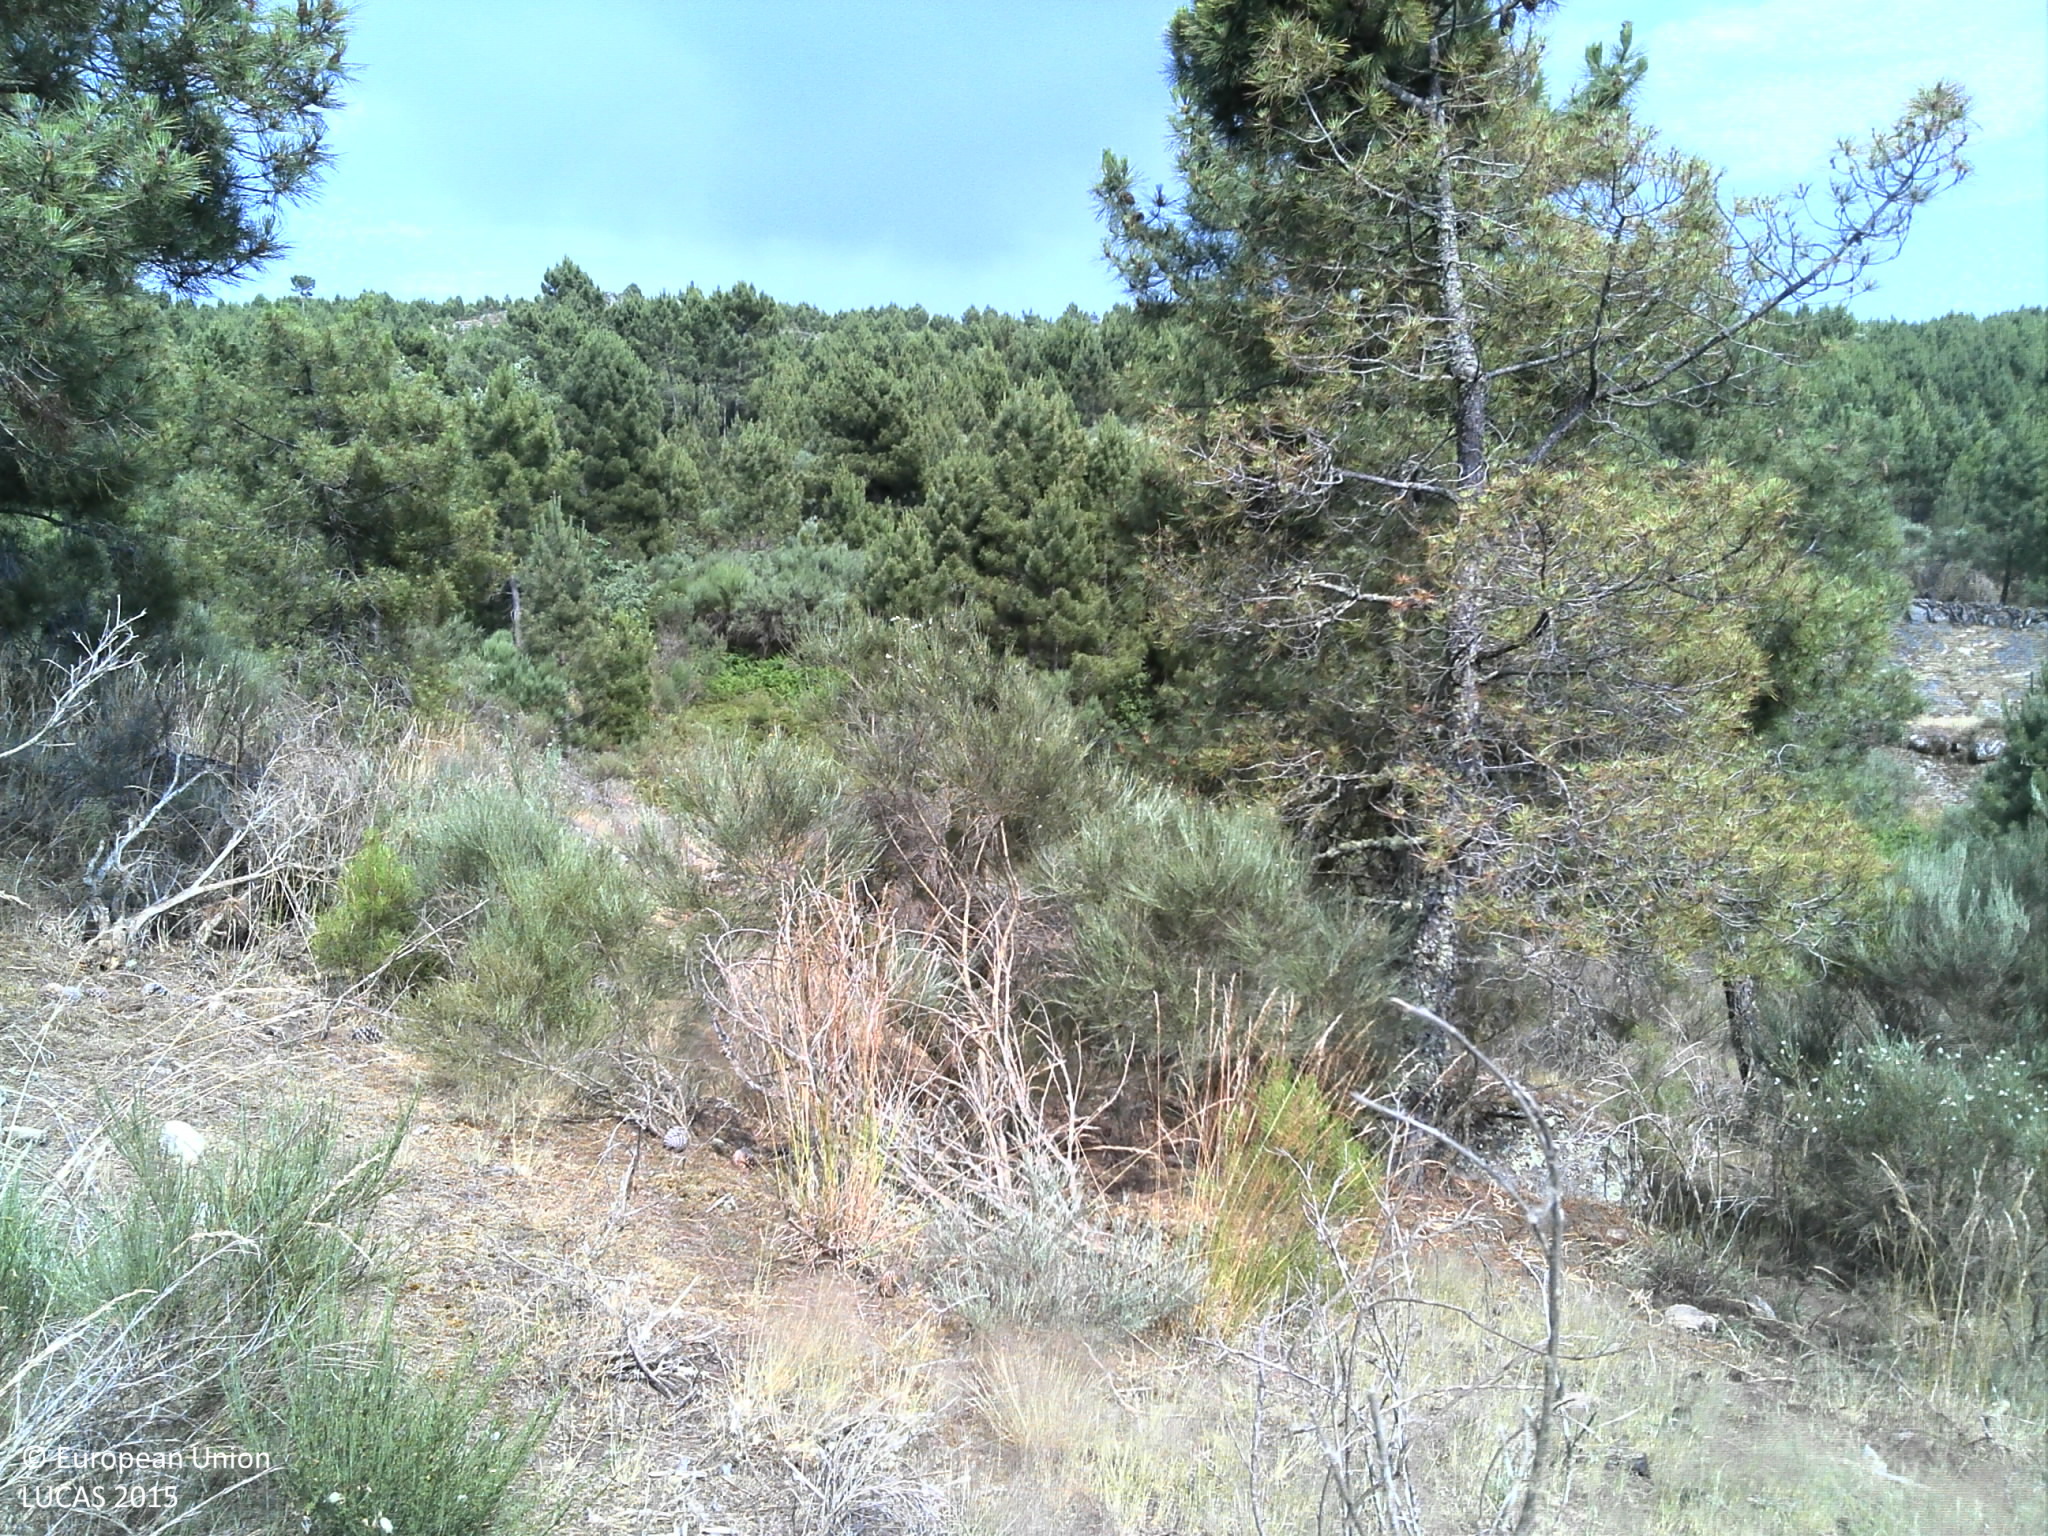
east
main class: Shrubland
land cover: Shrubland with sparse tree cover
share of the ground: > 75 %
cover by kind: shrubs 55 %, herbaceous plants 30 %, consolidated bare surface 10 %, coniferous forest trees 5 %
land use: Semi-natural and natural areas not in use
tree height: > 5 m
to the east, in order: Shrubland with sparse tree cover; Rock outcrops; Shrubland with sparse tree cover; Dry stone walls; Pine dominated coniferous woodland; Rock outcrops; Shrubland with sparse tree cover; Dry stone walls; Shrubland with sparse tree cover; Dry stone walls; Rock outcrops; Shrubland with sparse tree cover; Dry stone walls; Pine dominated coniferous woodland; Dry stone walls; Shruby margins; Tracks; Shrubland with sparse tree cover
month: June
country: PT
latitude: 41.3106
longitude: -7.6512
